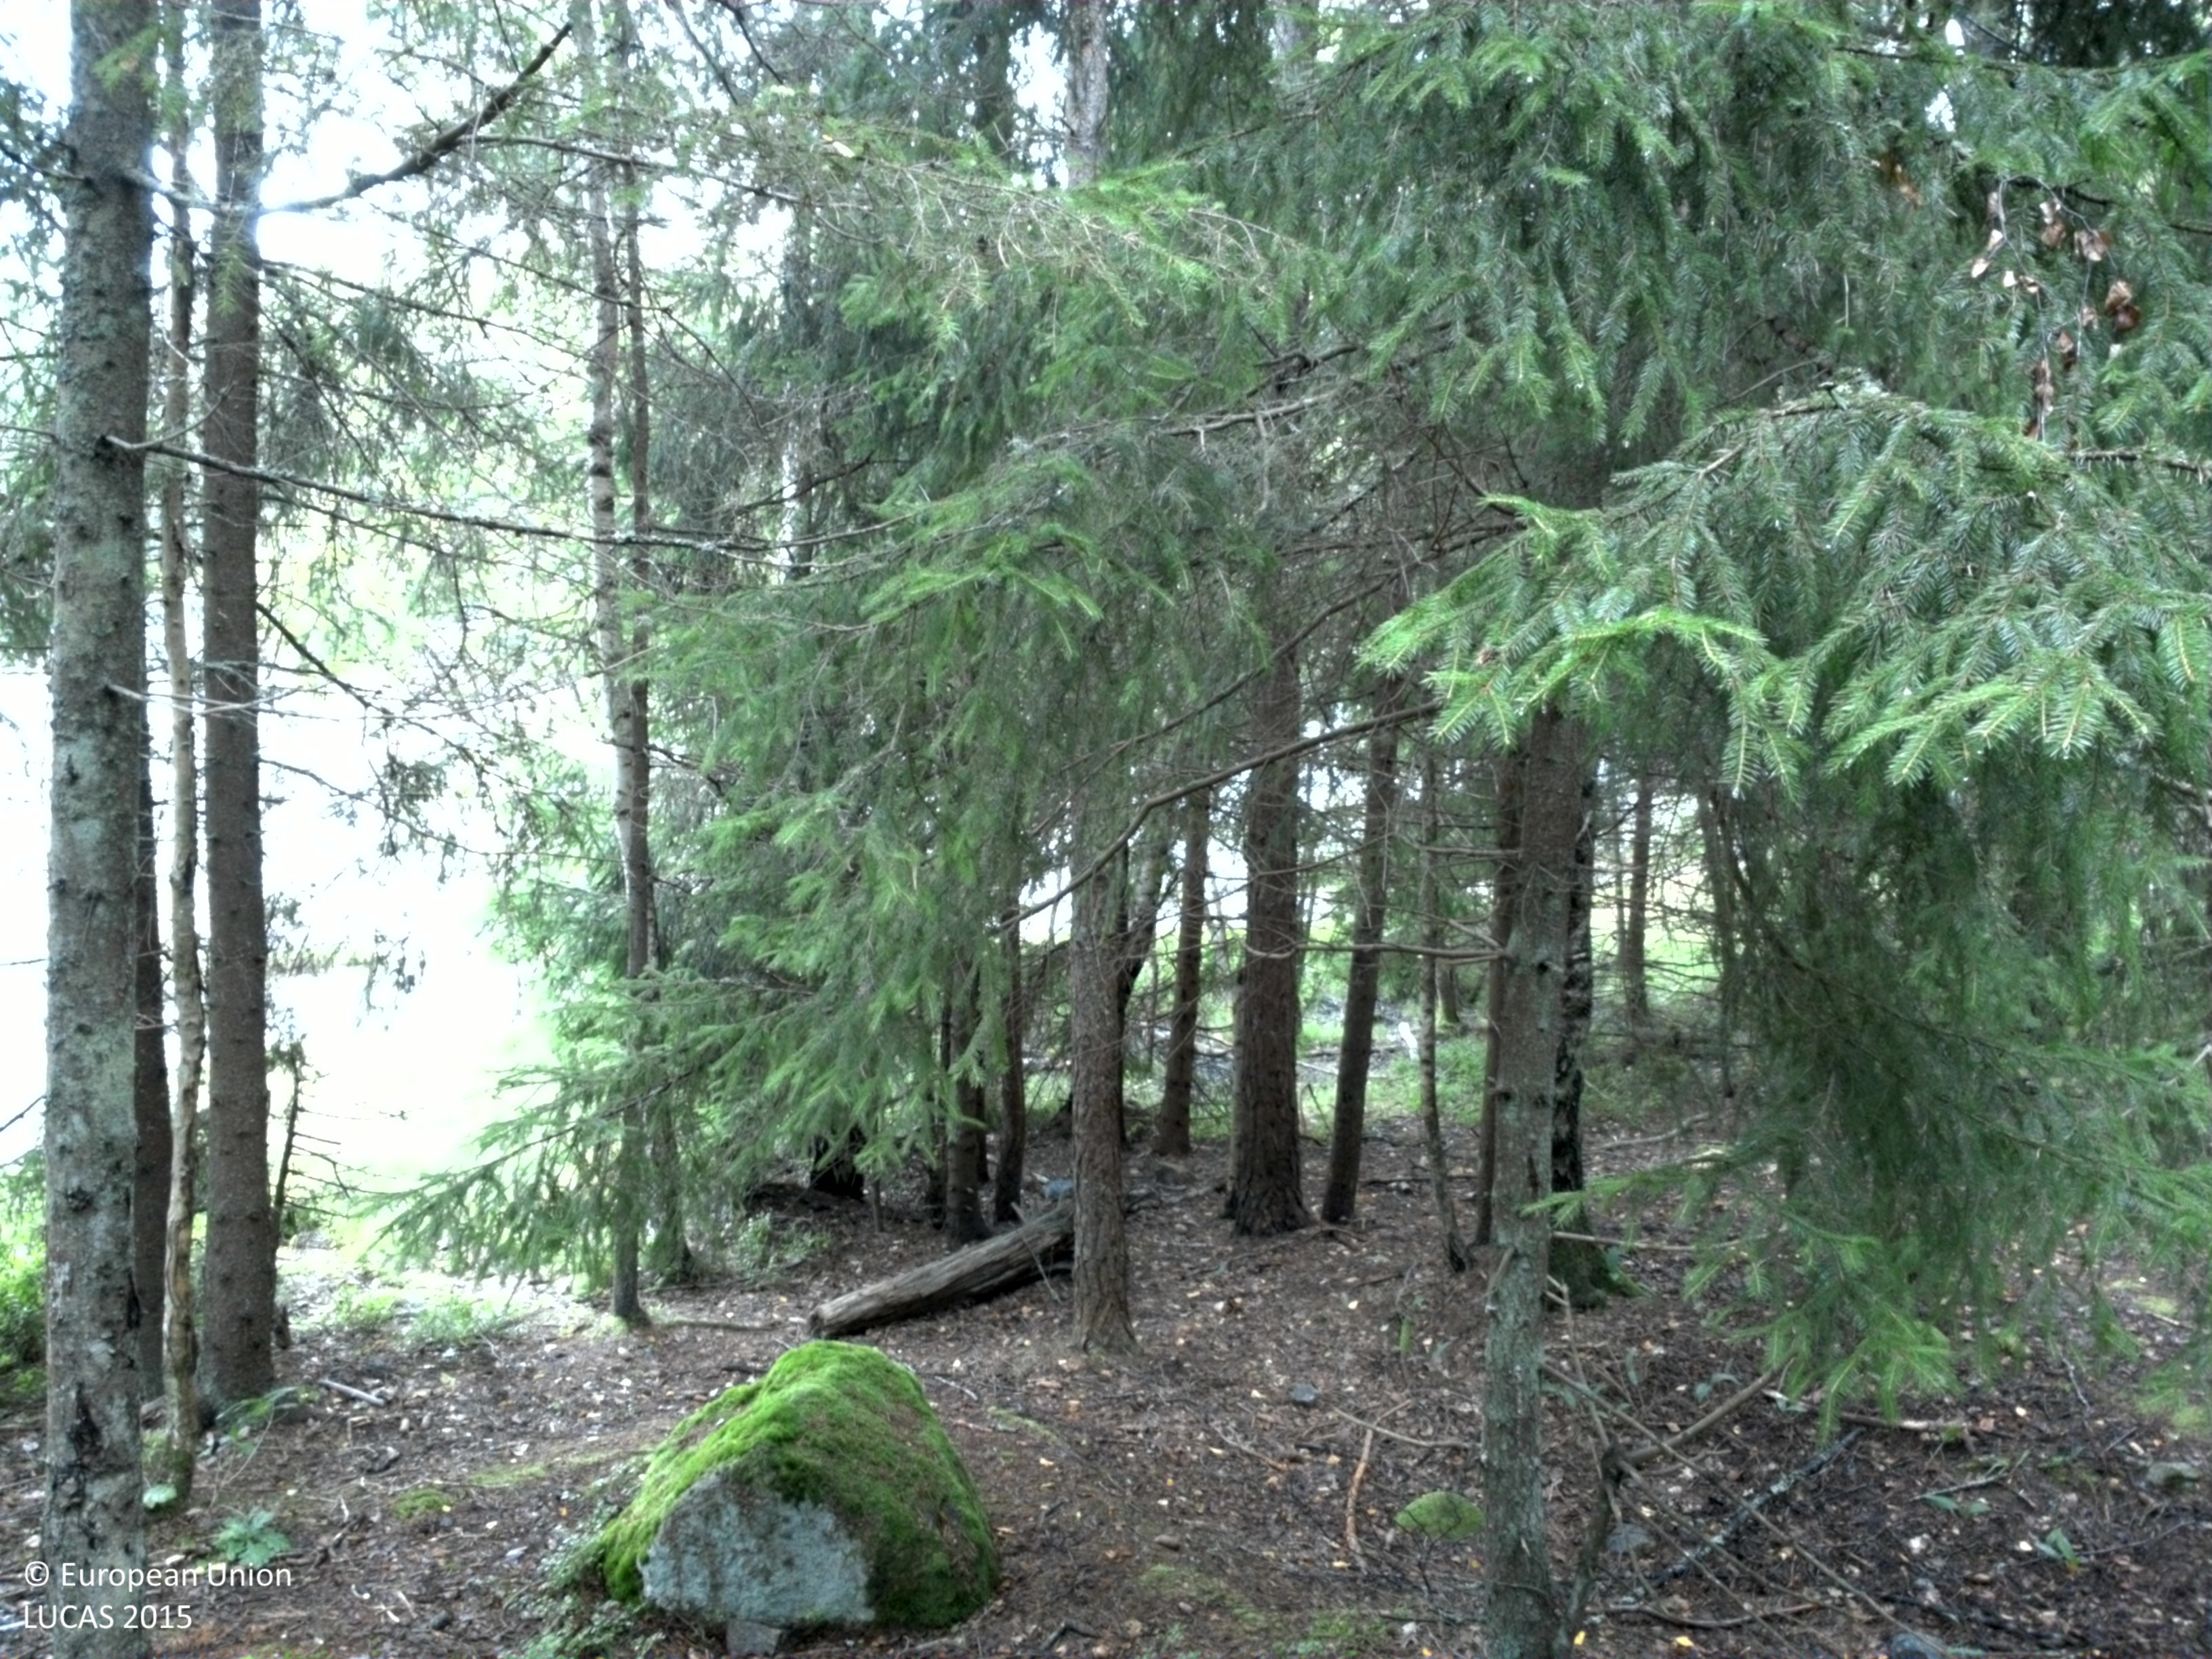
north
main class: Woodland
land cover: Spruce dominated mixed woodland
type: boreal forest
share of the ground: 50 - 75 %
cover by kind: coniferous forest trees 45 %, lichens and mosses 30 %, broadleaved forest trees 15 %, shrubs 10 %
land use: Forestry
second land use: Amenities, museums, leisure
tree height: > 5 m
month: July
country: SE
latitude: 59.5001
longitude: 18.3190
